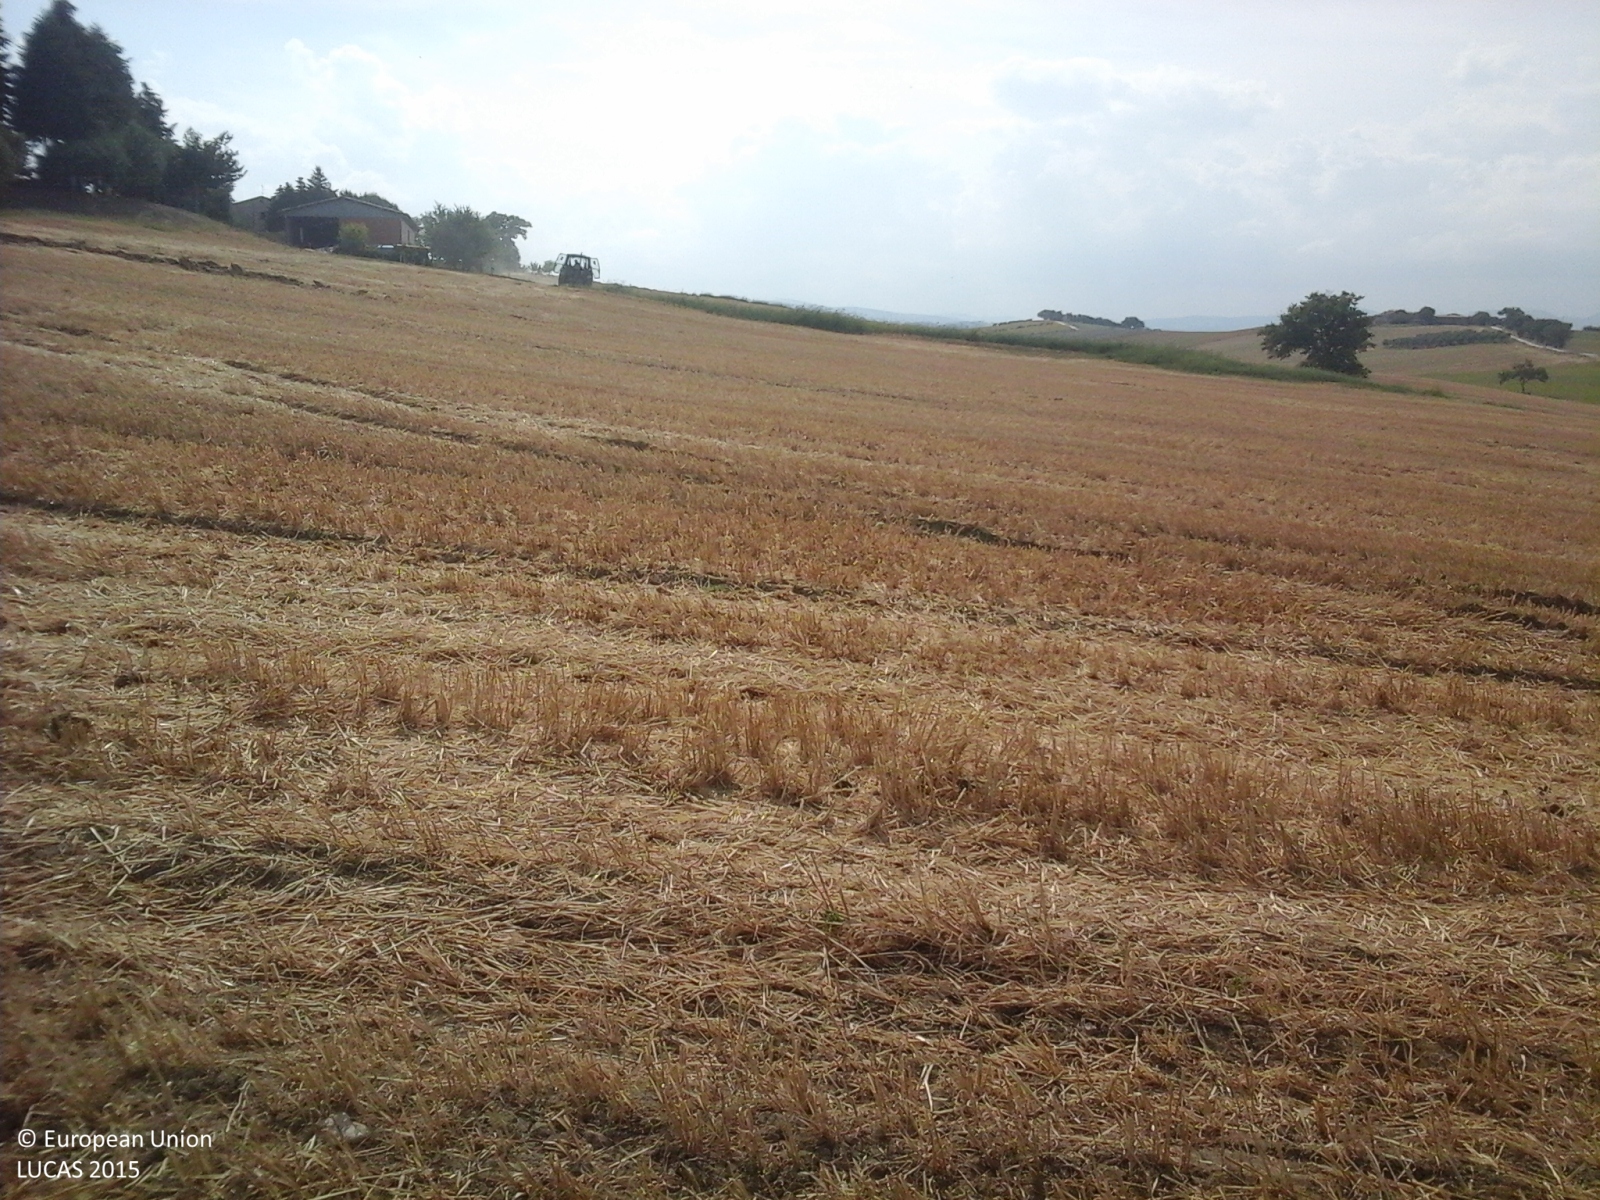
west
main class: Cropland
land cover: Durum wheat
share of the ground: > 75 %
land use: Agriculture (excluding fallow land and kitchen gardens)
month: July
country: IT
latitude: 43.2122
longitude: 13.3761
